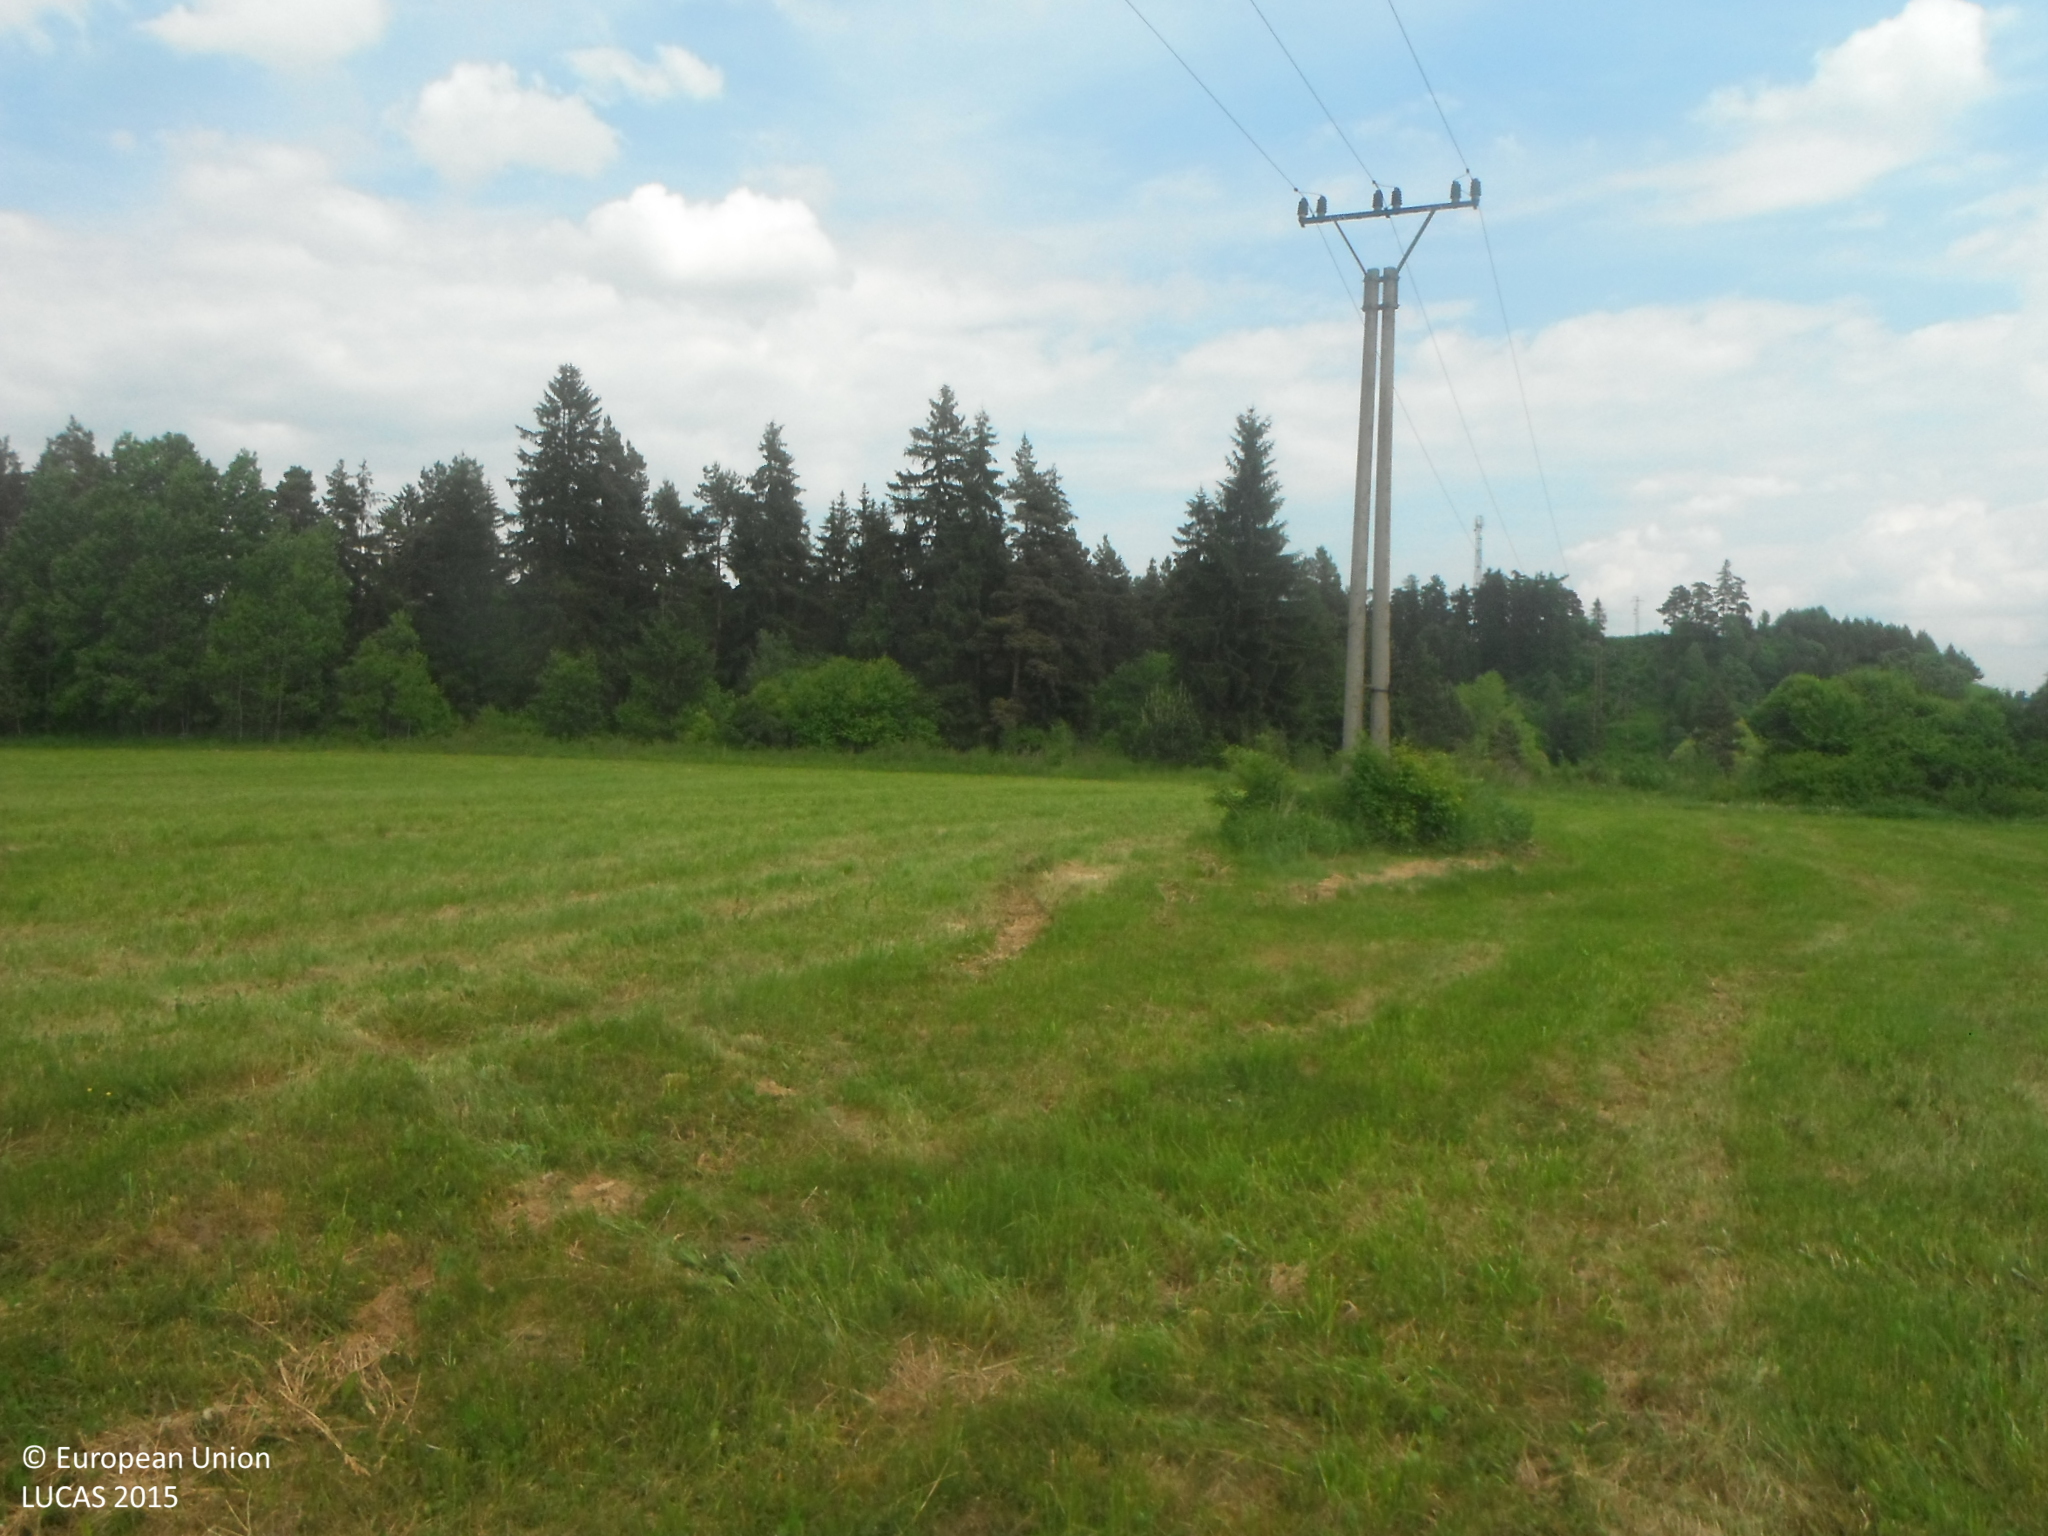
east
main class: Grassland
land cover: Grassland without tree/shrub cover
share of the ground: > 75 %
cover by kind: herbaceous plants 100 %
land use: Agriculture (excluding fallow land and kitchen gardens)
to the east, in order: Grassland without tree/shrub cover; Electric lines; Grassland without tree/shrub cover; Tracks; Grass margins; Spruce dominated coniferous woodland; Tracks; Spruce dominated coniferous woodland; Rocks and stones; Inland fresh running water
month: June
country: SK
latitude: 49.0581
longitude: 19.7583
